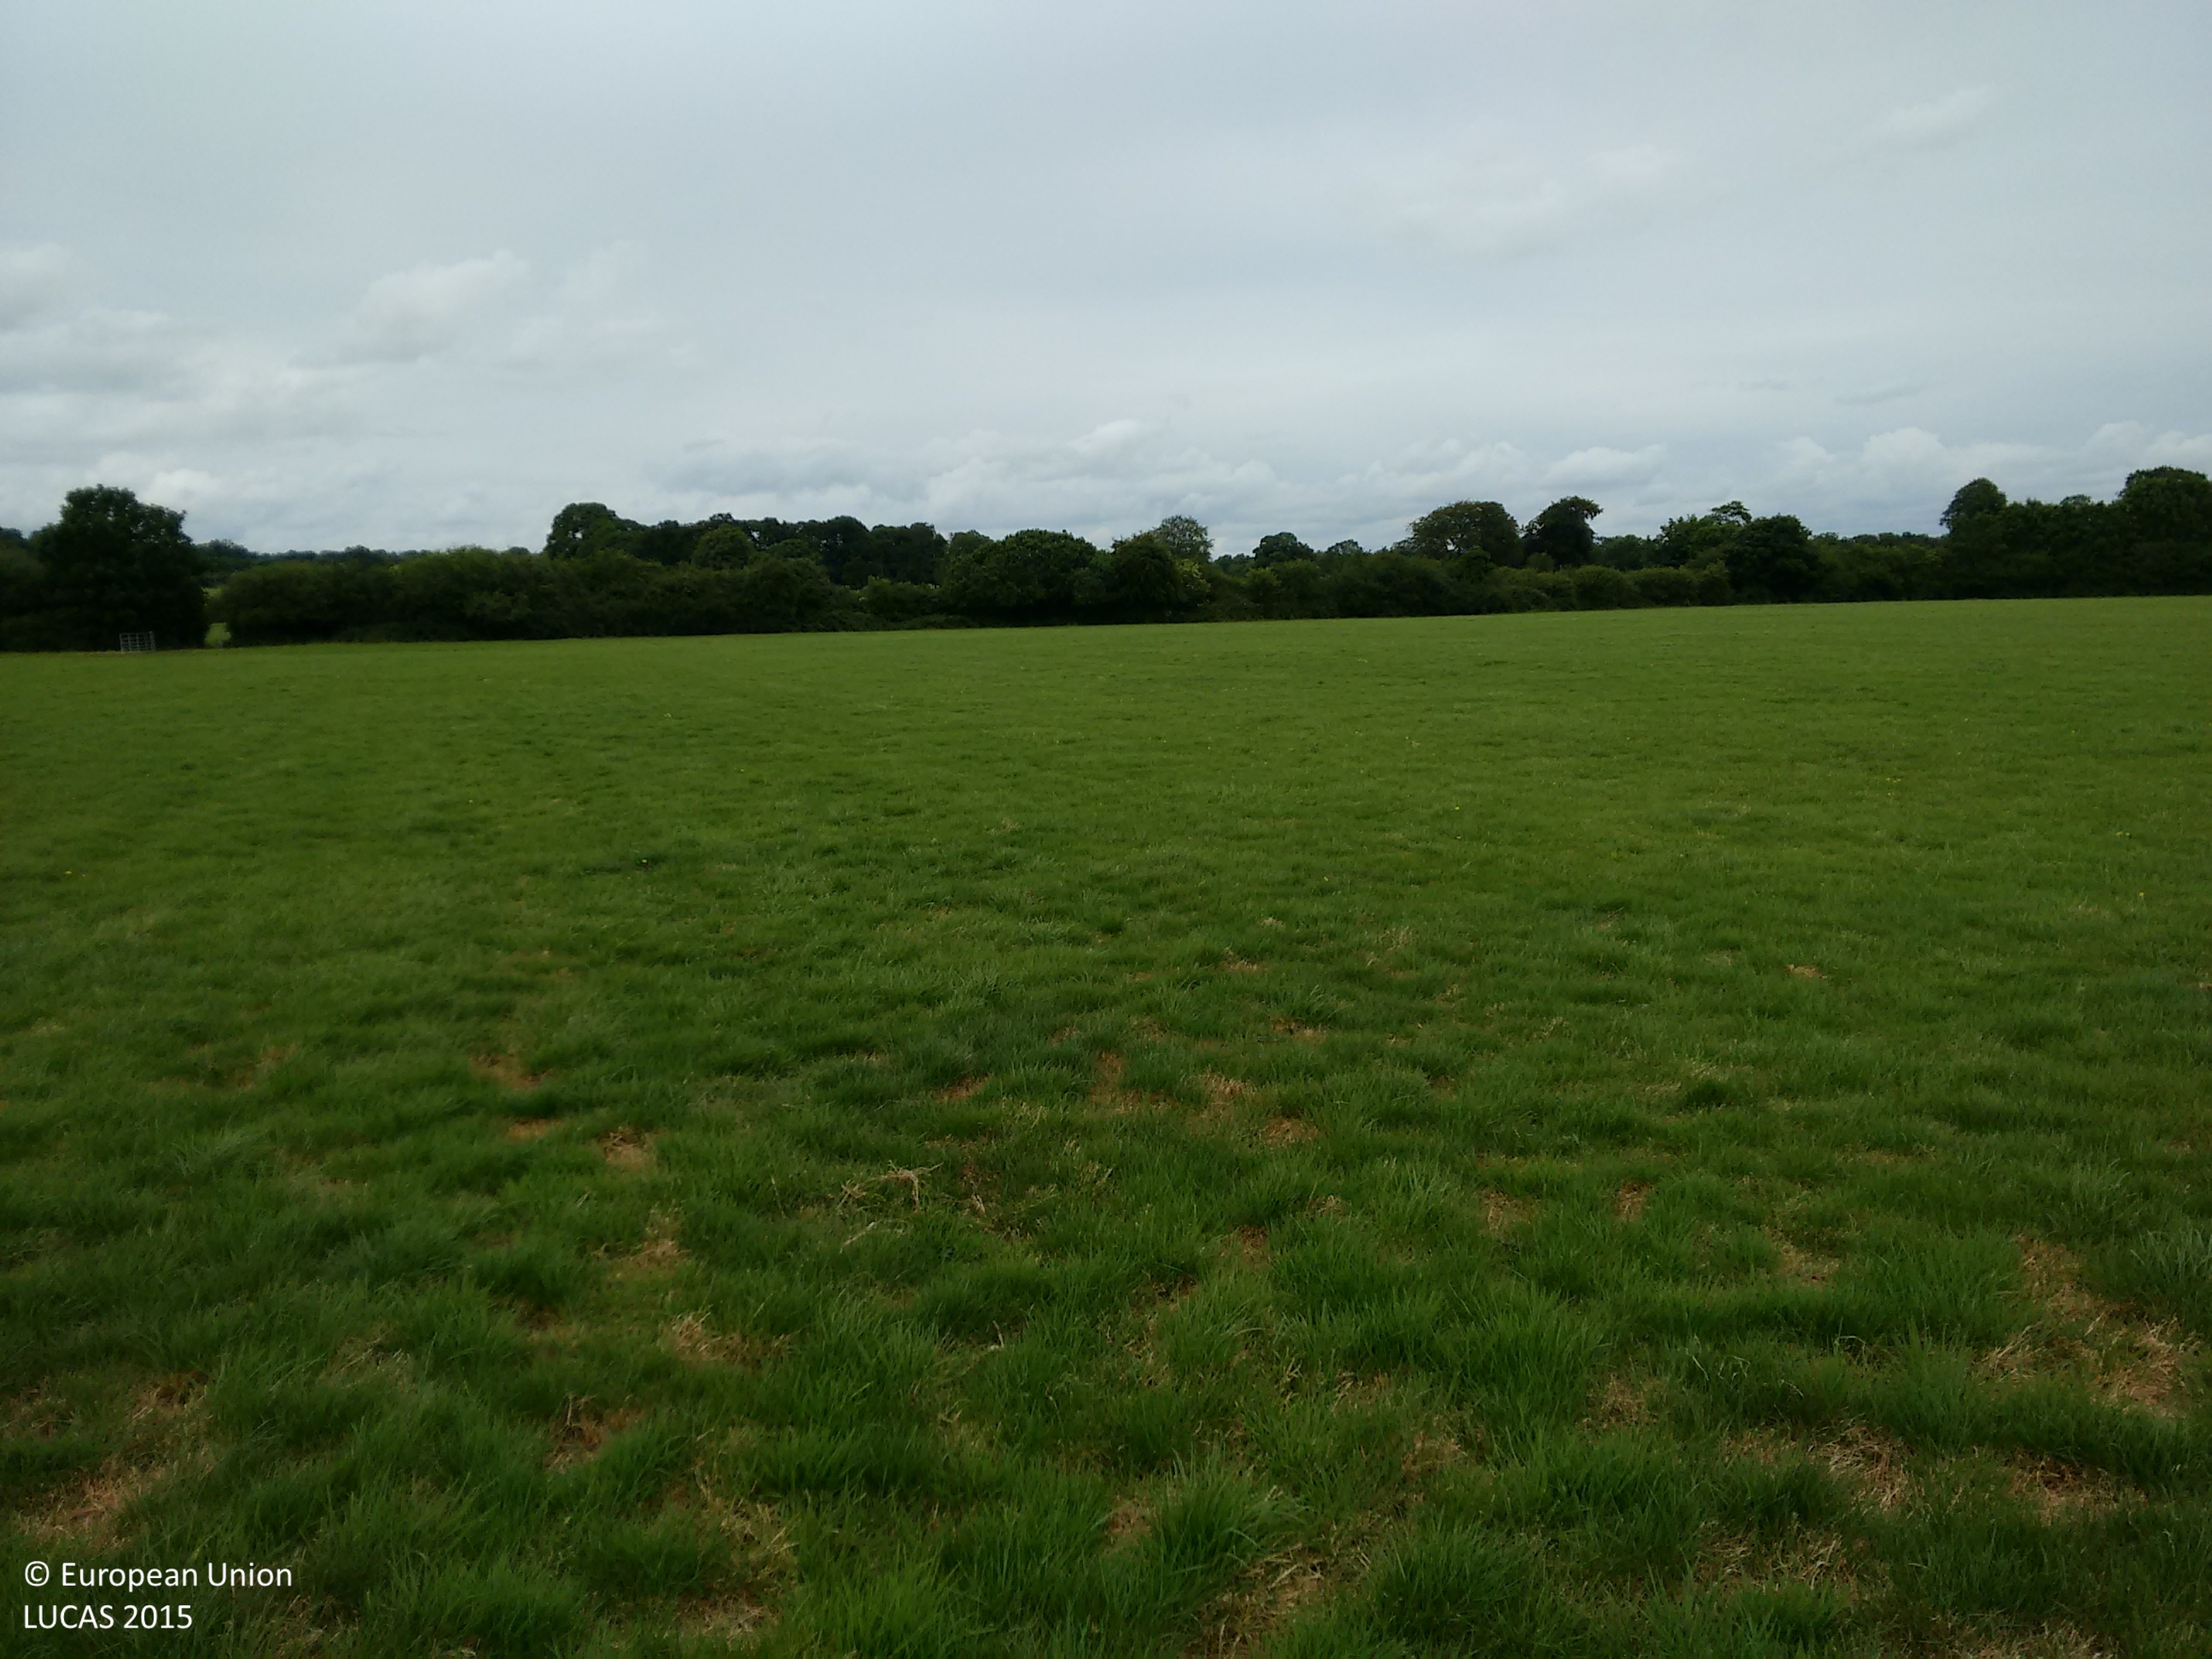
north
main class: Grassland
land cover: Grassland without tree/shrub cover
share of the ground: > 75 %
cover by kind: herbaceous plants 100 %
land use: Agriculture (excluding fallow land and kitchen gardens)
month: July
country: IE
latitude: 52.5564
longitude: -7.4895
